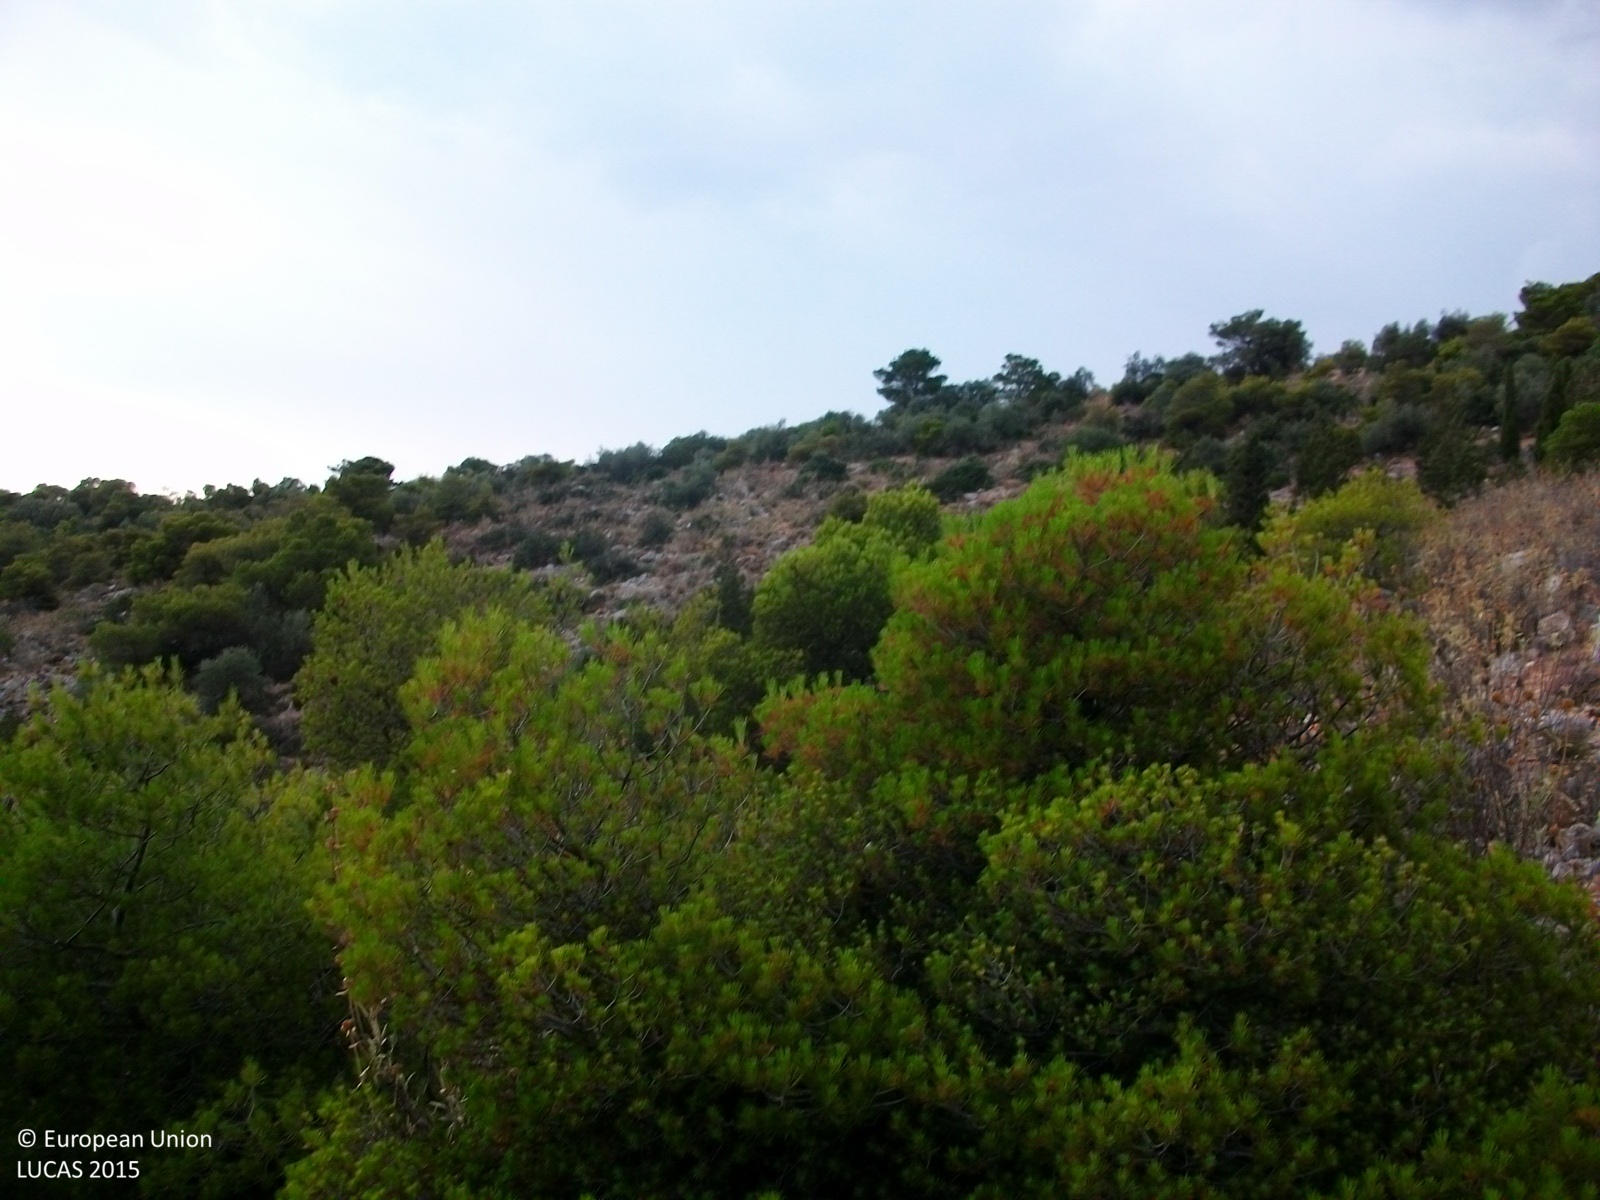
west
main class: Woodland
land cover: Pine dominated coniferous woodland
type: coniferous forest of the mediterranean region
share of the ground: 10 - 25 %
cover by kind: shrubs 30 %, herbaceous plants 30 %, coniferous forest trees 20 %, consolidated bare surface 20 %
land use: Semi-natural and natural areas not in use
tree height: < 5 m
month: June
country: GR
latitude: 38.0264
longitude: 23.6393
